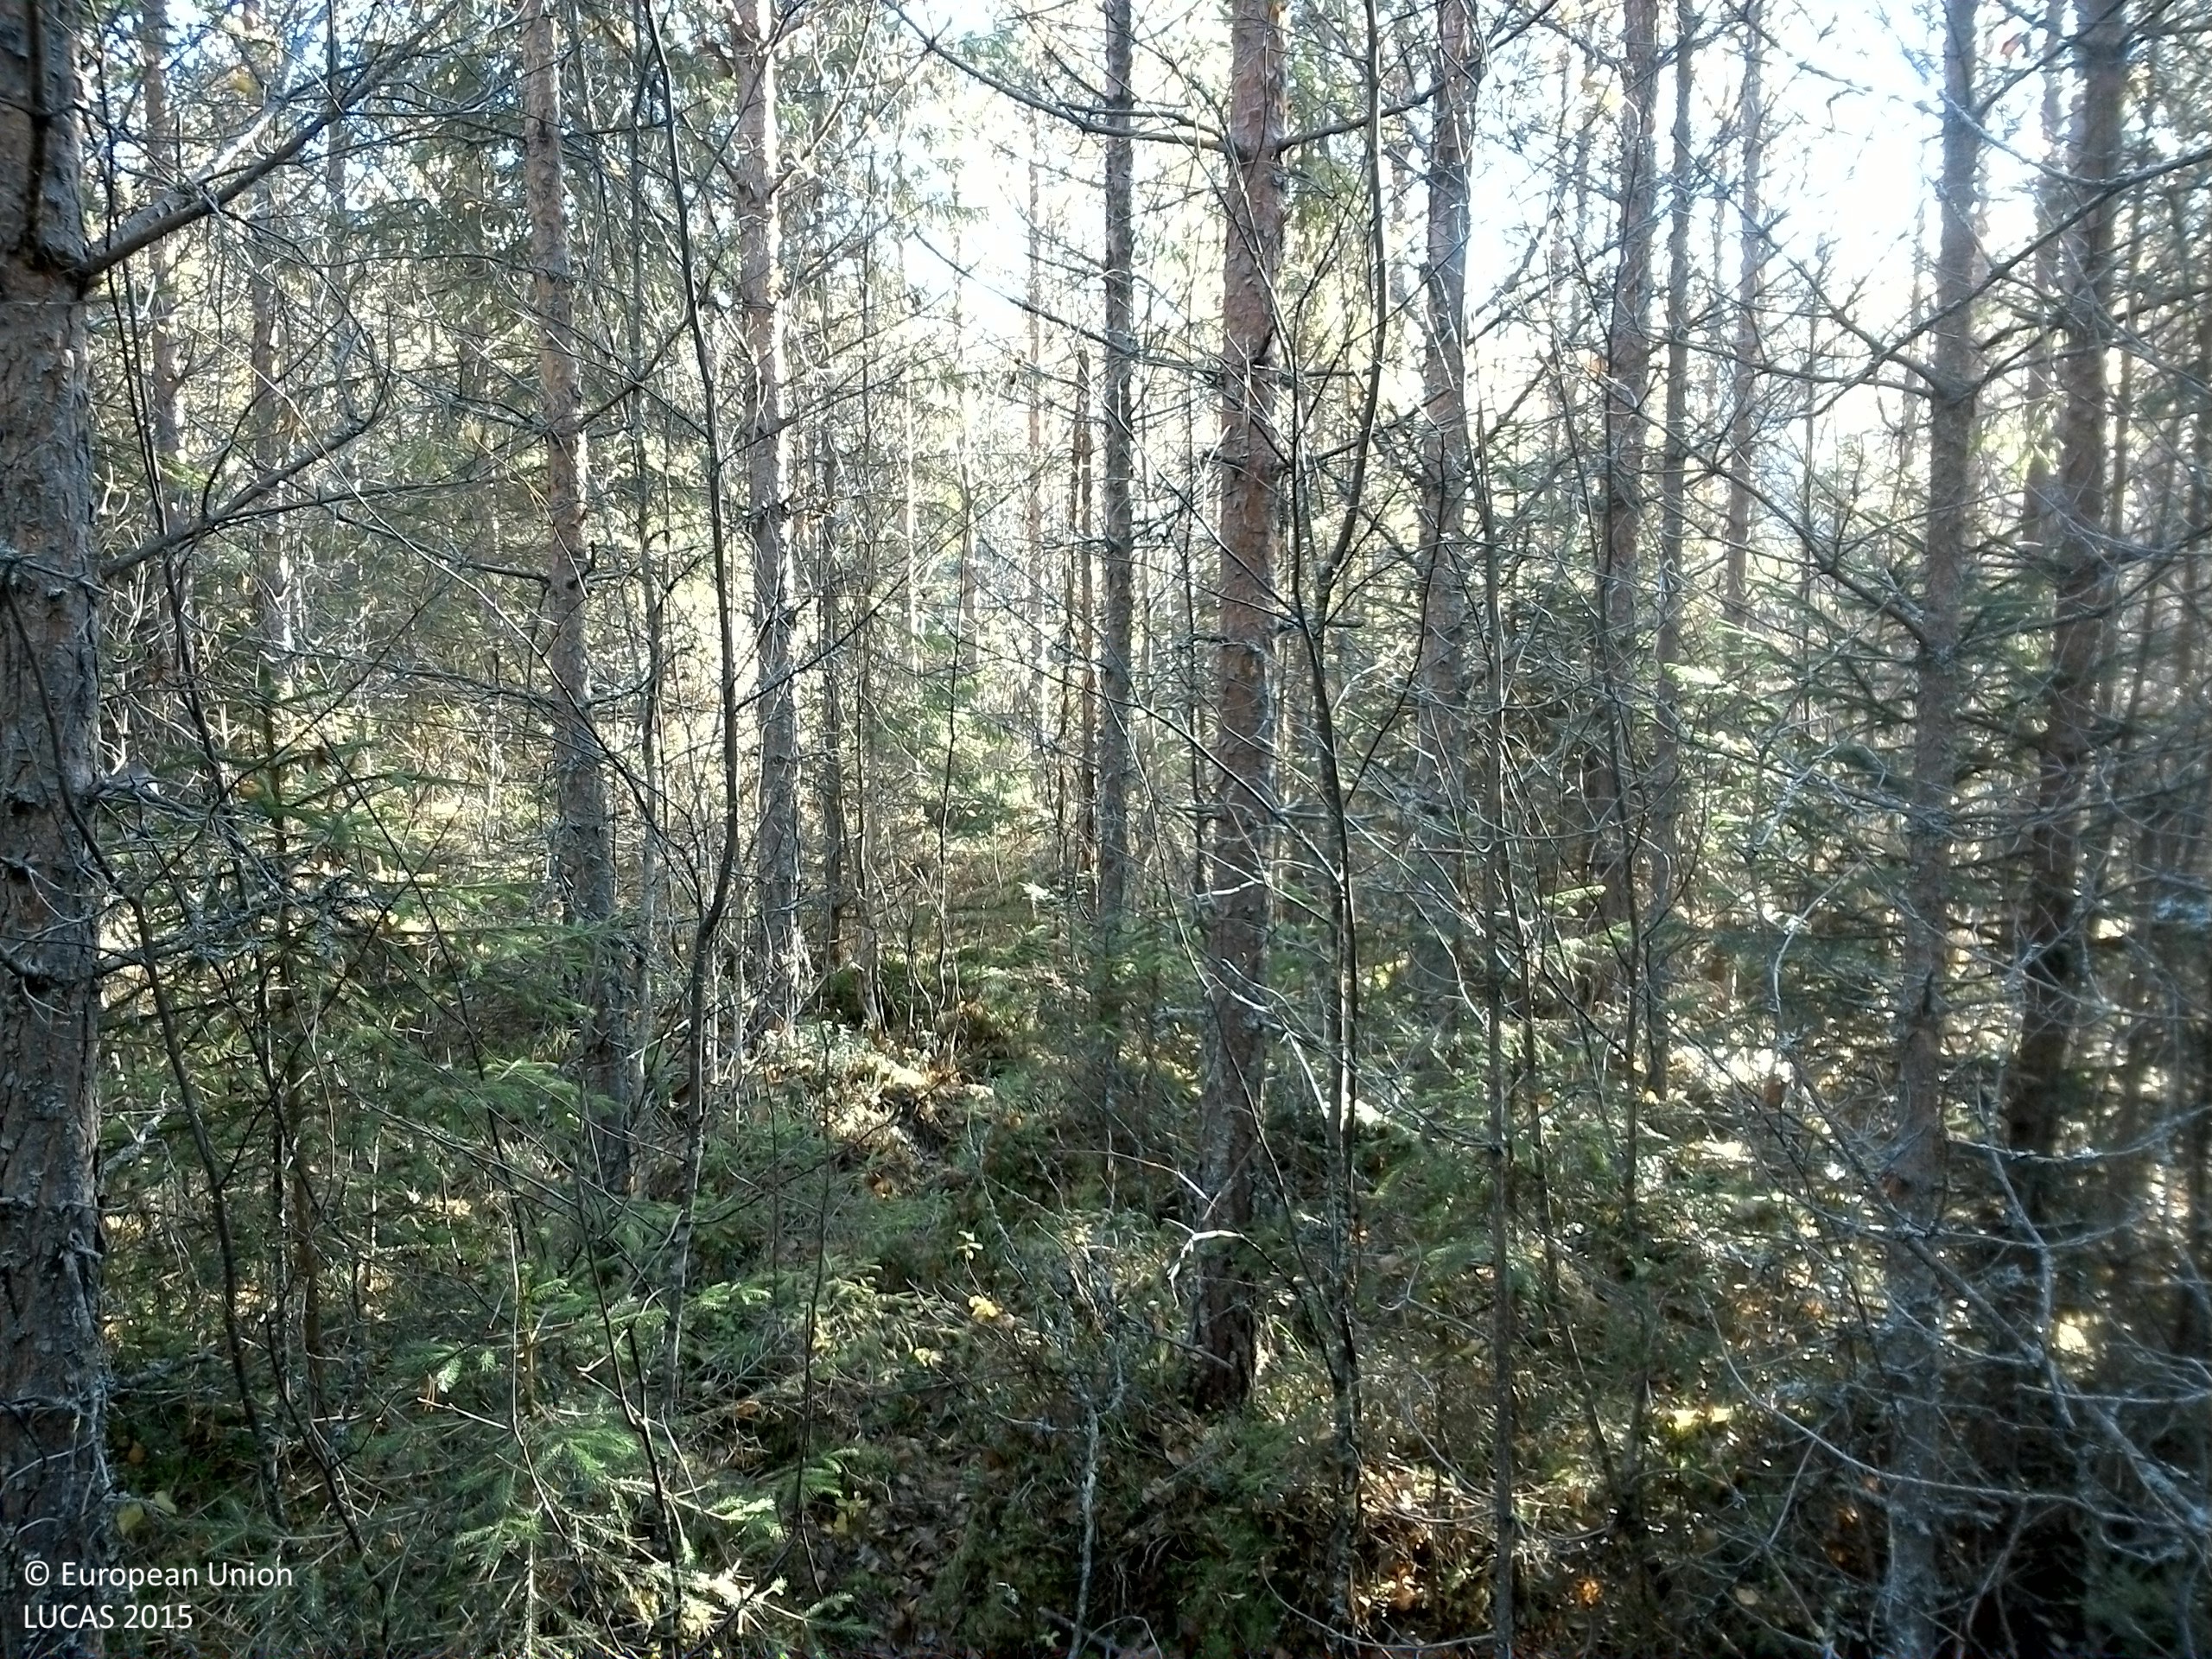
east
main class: Woodland
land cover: Pine dominated coniferous woodland
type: boreal forest
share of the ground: > 75 %
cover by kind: coniferous forest trees 75 %, shrubs 15 %, lichens and mosses 10 %
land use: Forestry
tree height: > 5 m
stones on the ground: < 10 %
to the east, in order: Pine dominated coniferous woodland; Rivers and streams; Pine dominated coniferous woodland; Rivers and streams; Pine dominated coniferous woodland; Broadleaved woodland; Pine dominated coniferous woodland; Paved roads, cycling and walking lanes; Pine dominated coniferous woodland
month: October
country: SE
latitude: 61.1269
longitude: 14.2381
